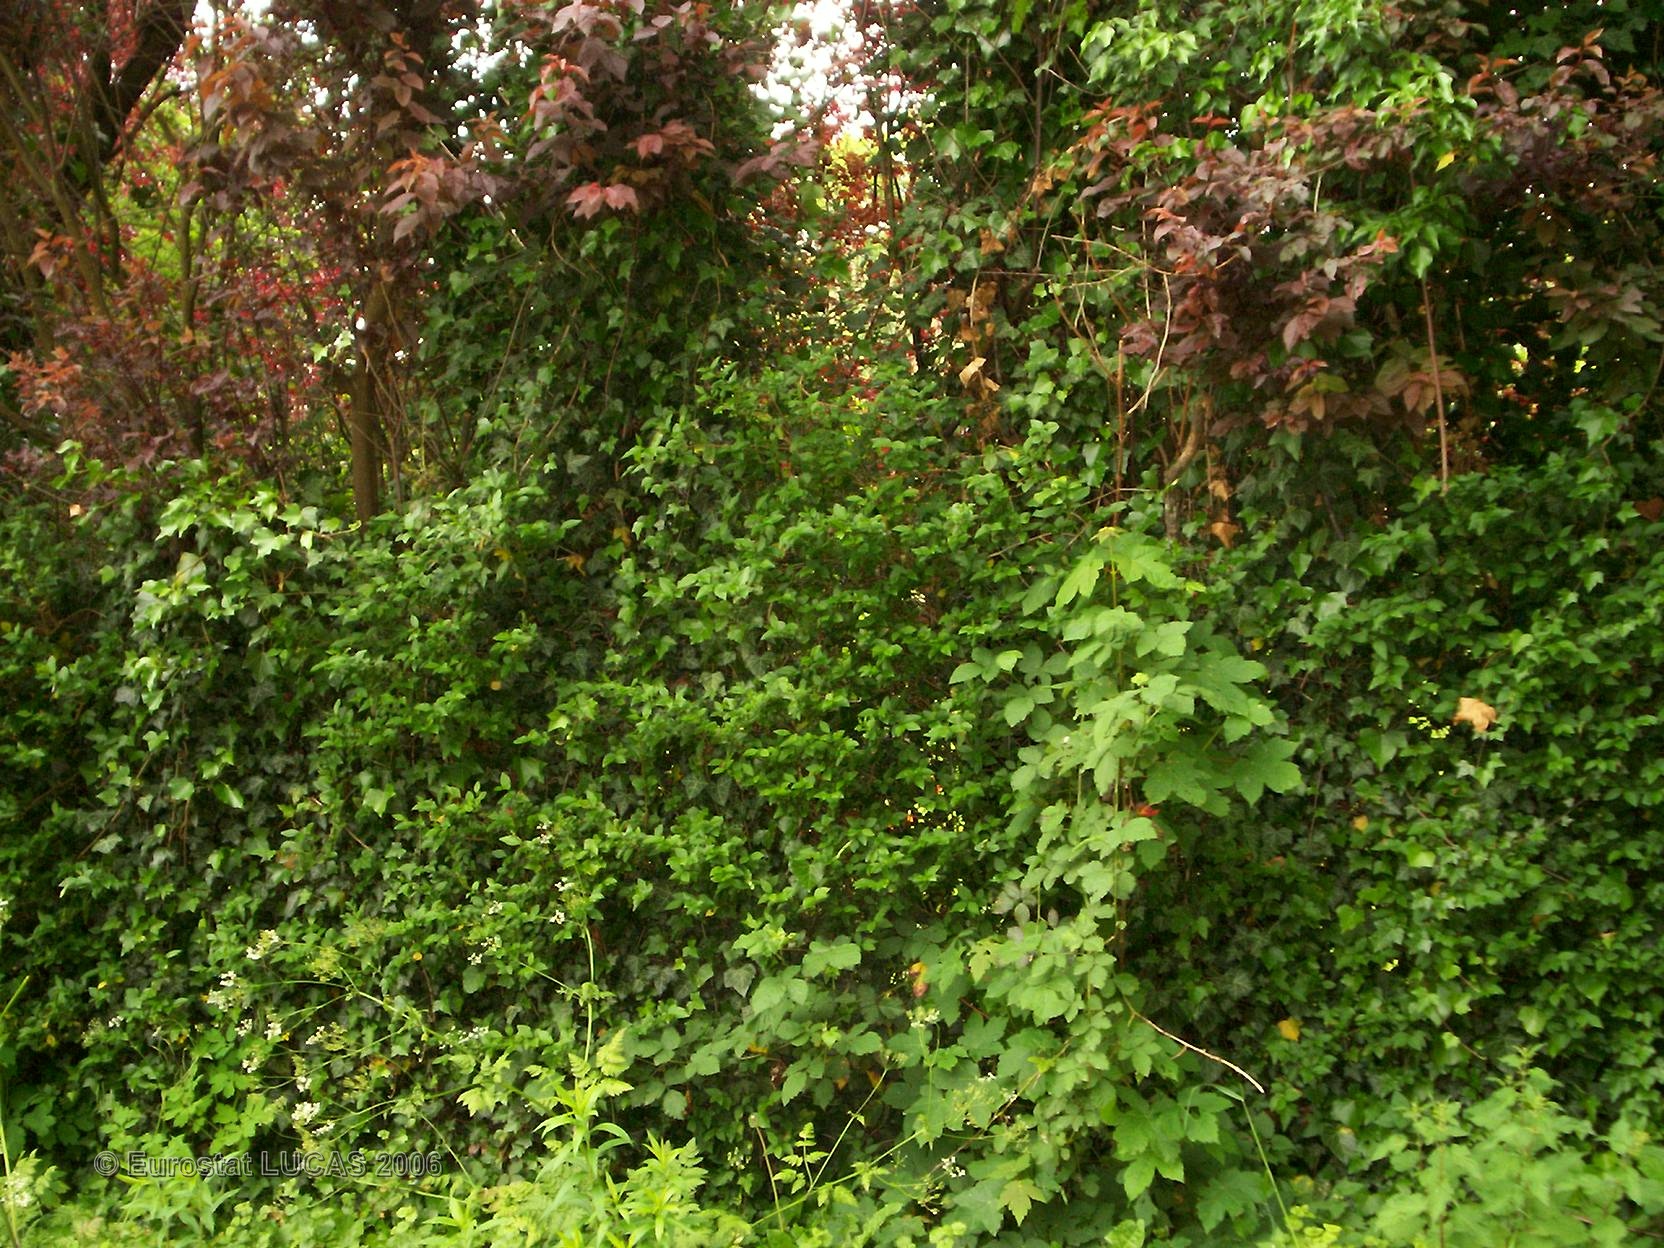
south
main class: Grassland
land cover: Grassland with sparse tree/shrub cover
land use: Residential
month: May
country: FR
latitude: 48.4548
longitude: 2.7567
